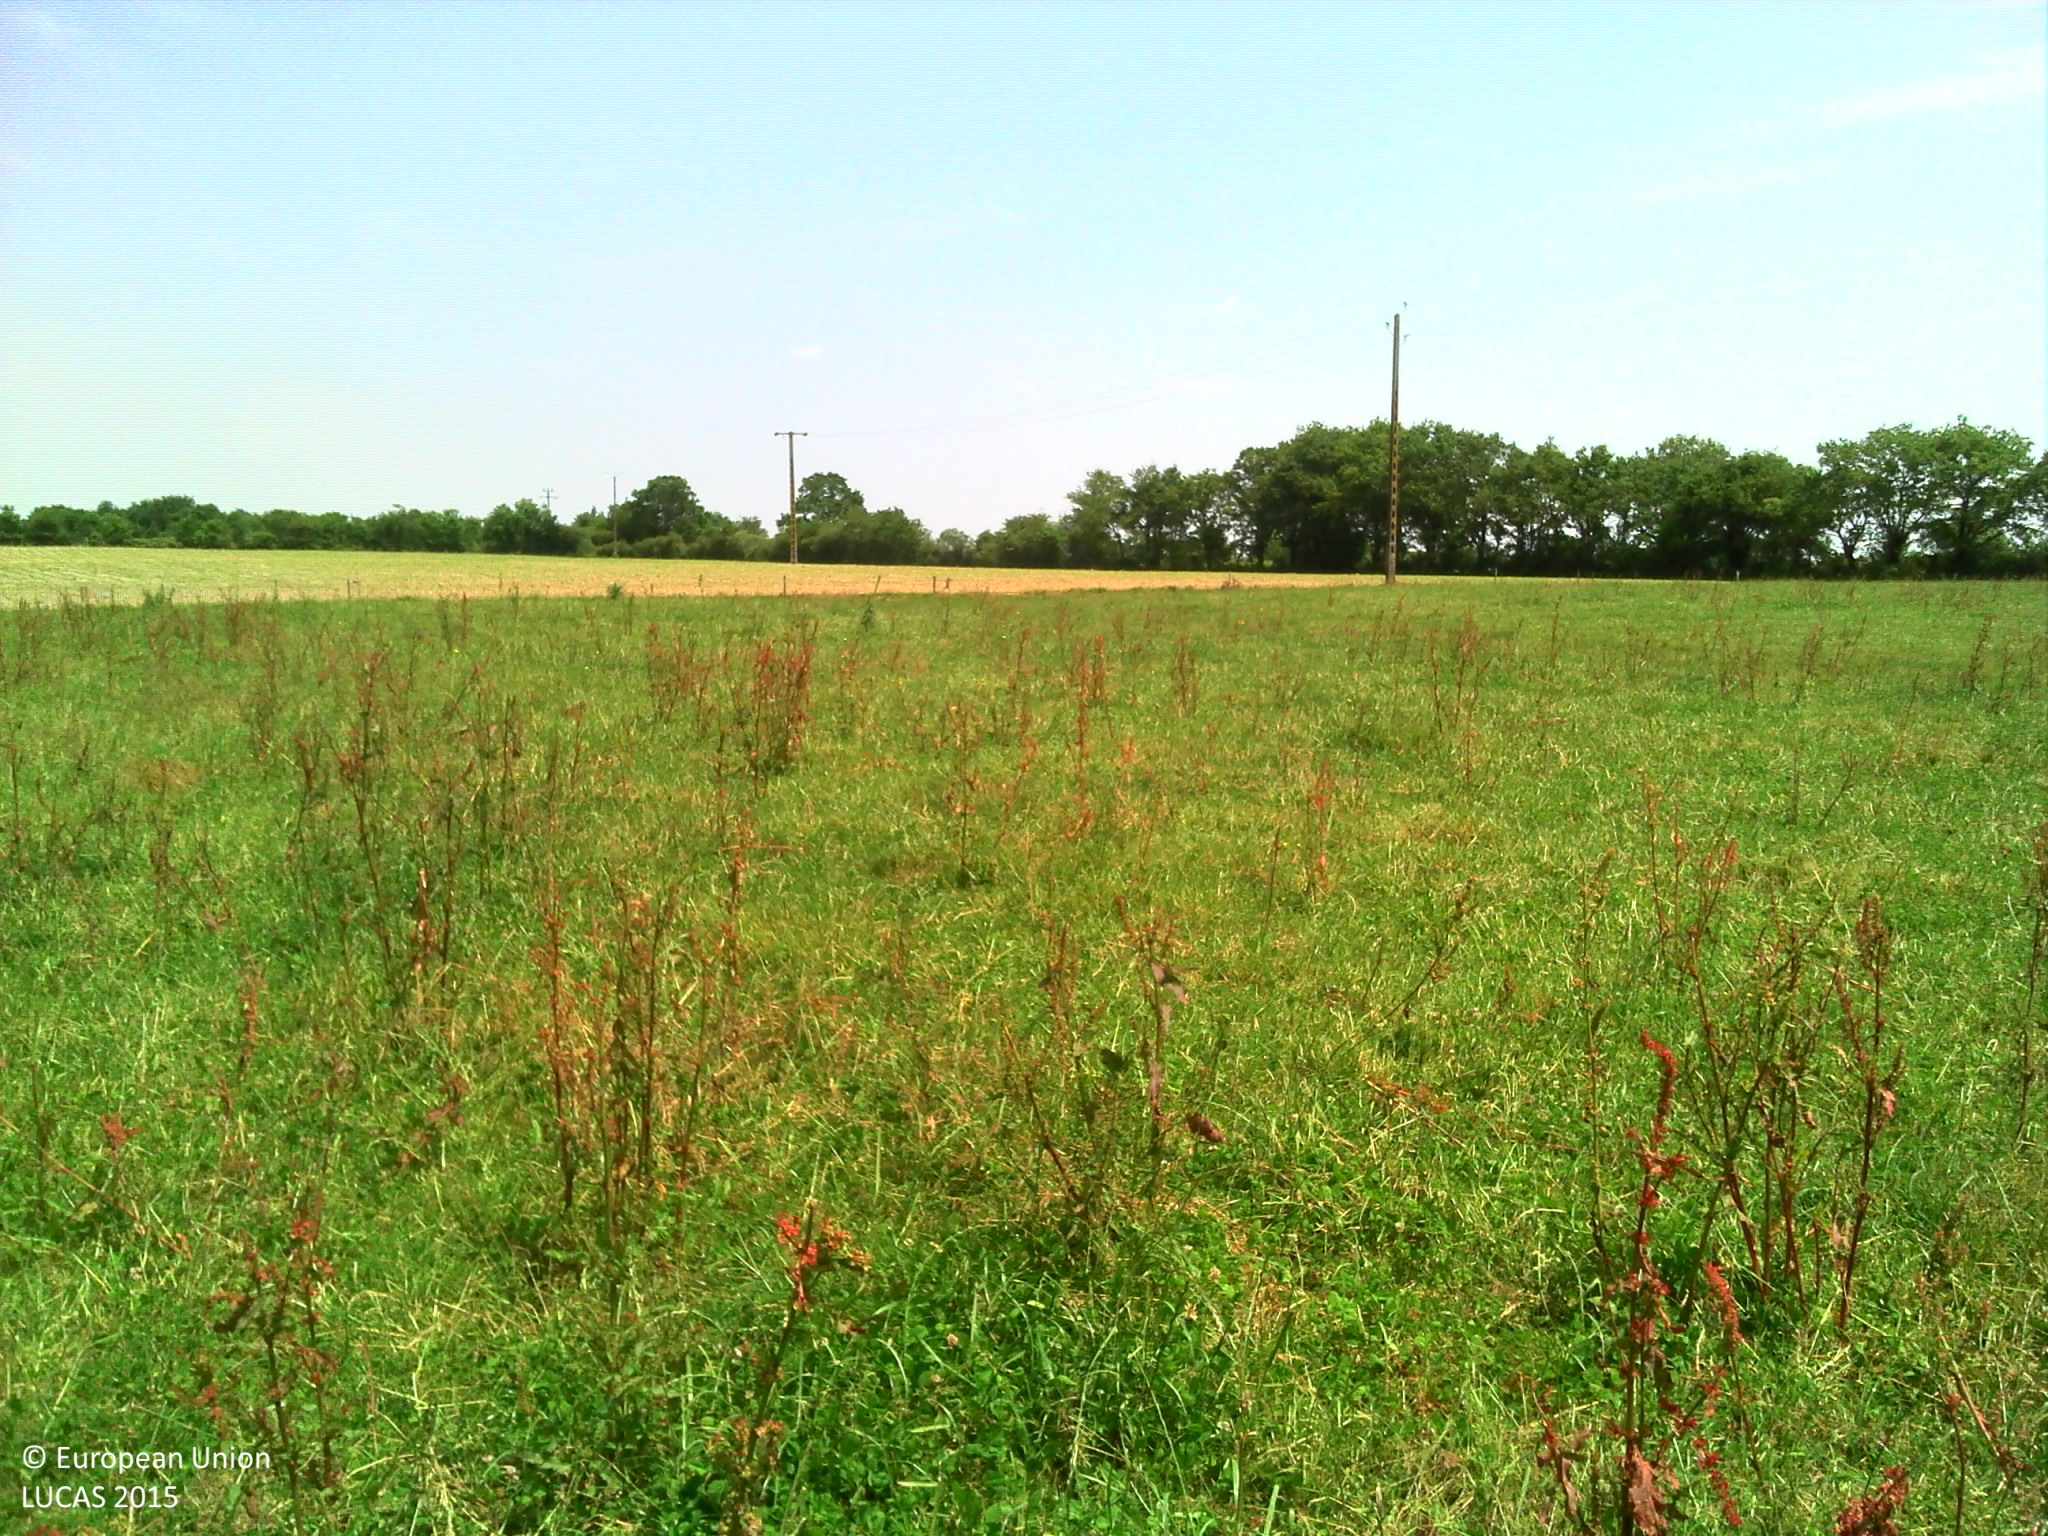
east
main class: Grassland
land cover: Grassland without tree/shrub cover
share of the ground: > 75 %
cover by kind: herbaceous plants 100 %
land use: Agriculture (excluding fallow land and kitchen gardens)
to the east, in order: Grassland without tree/shrub cover; Electric lines; Managed hedges; Ditches and canals; Tracks; Ditches and canals; Artificial constructions in urban areas; Spontaneously vegetated surfaces
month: June
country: FR
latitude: 46.8169
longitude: -1.6936
